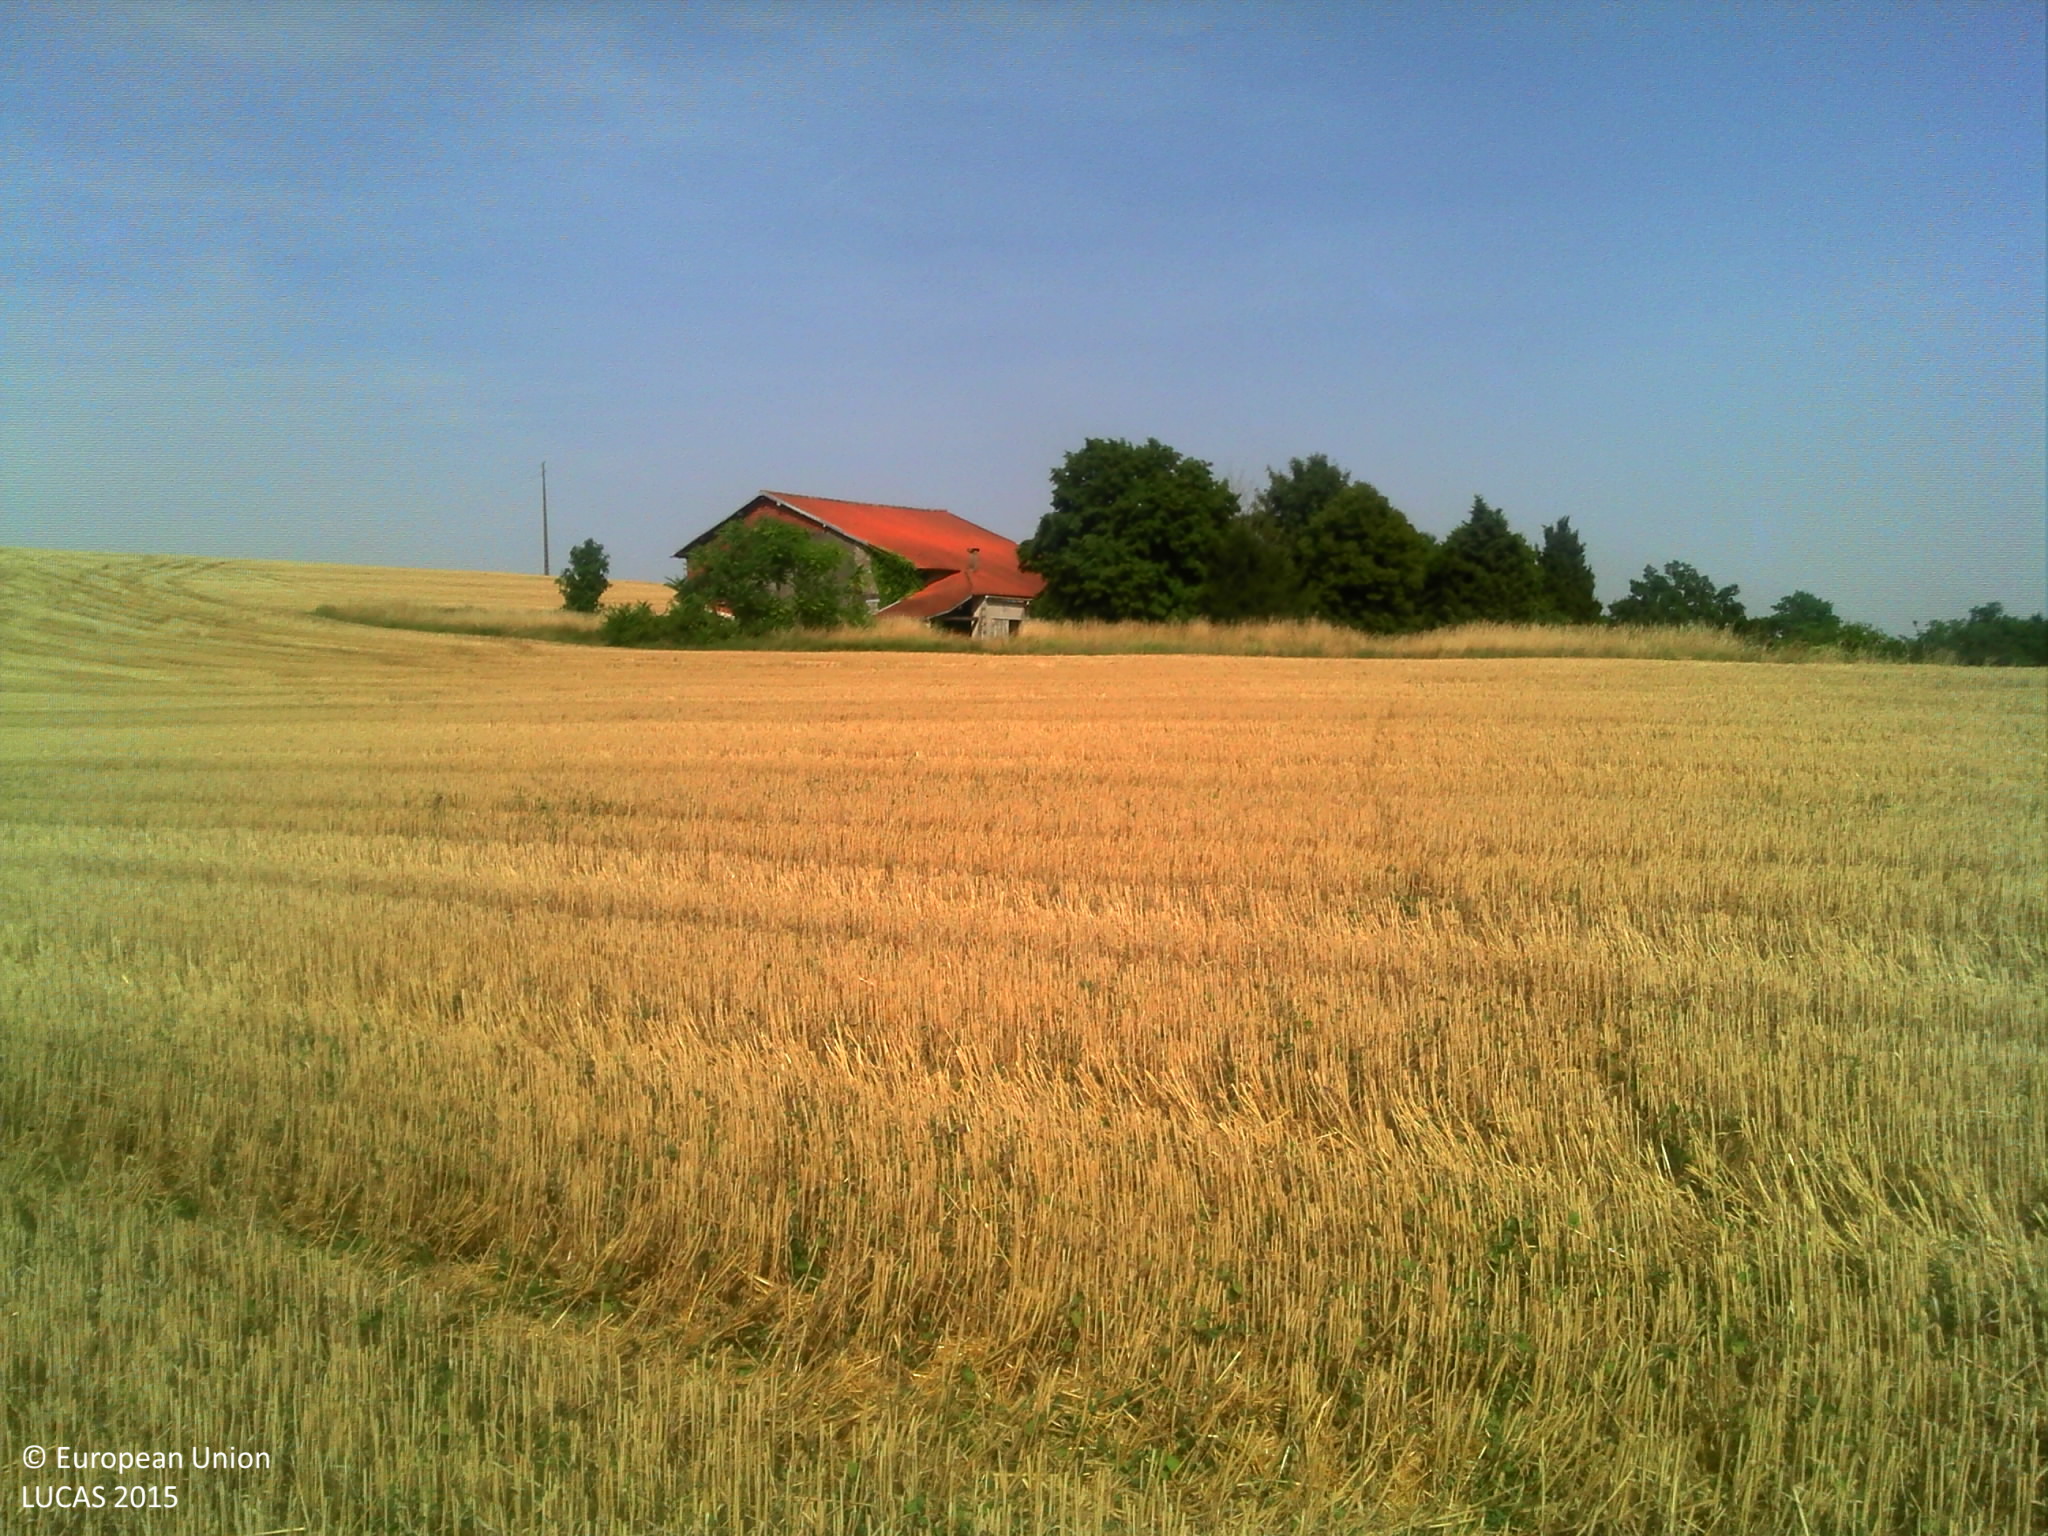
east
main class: Cropland
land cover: Common wheat
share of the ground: > 75 %
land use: Agriculture (excluding fallow land and kitchen gardens)
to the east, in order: Common wheat; Artificial constructions in urban areas; Durum wheat
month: July
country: FR
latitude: 43.6986
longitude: 0.9290
